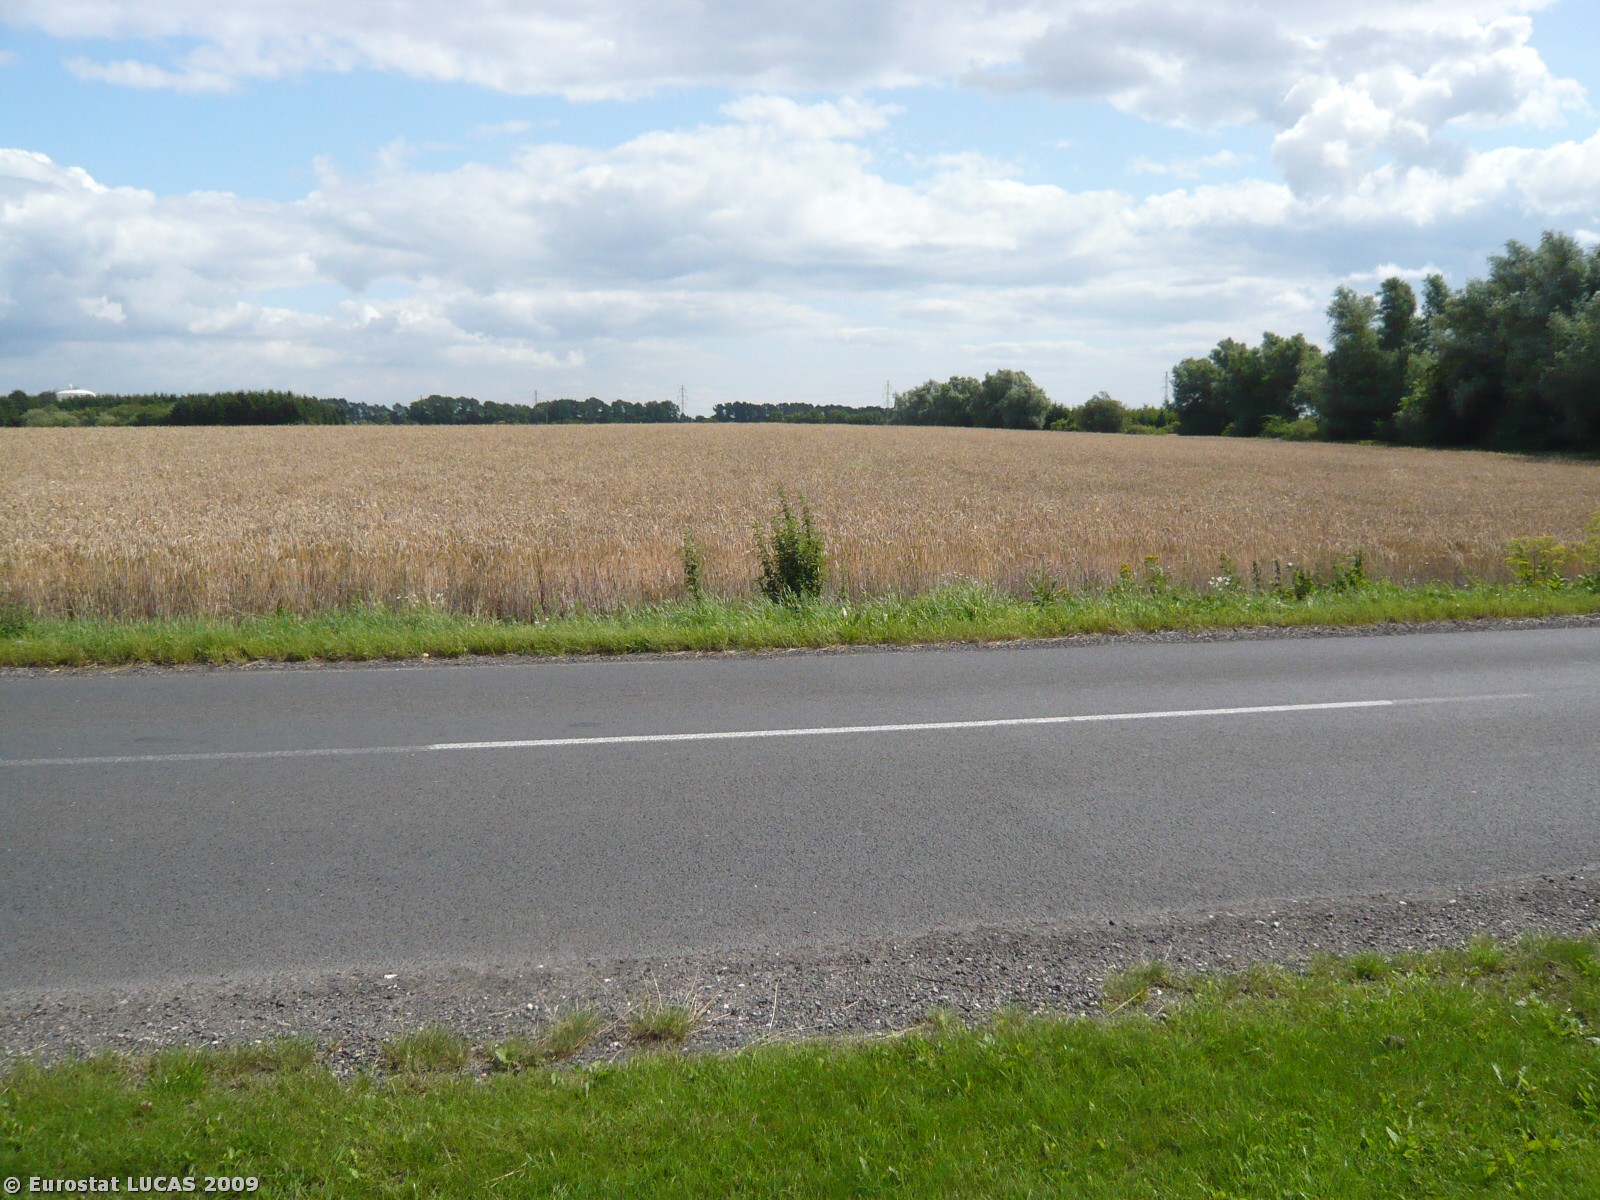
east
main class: Artificial land
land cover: Non built-up linear features
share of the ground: > 75 %
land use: Road transport
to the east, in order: Non built-up linear features; Grassland with sparse tree/shrub cover; Lines of trees; Paved roads, cycling and walking lanes; Grass margins; Ditches and canals; Rye
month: July
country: DK
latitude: 55.5047
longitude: 12.1357
